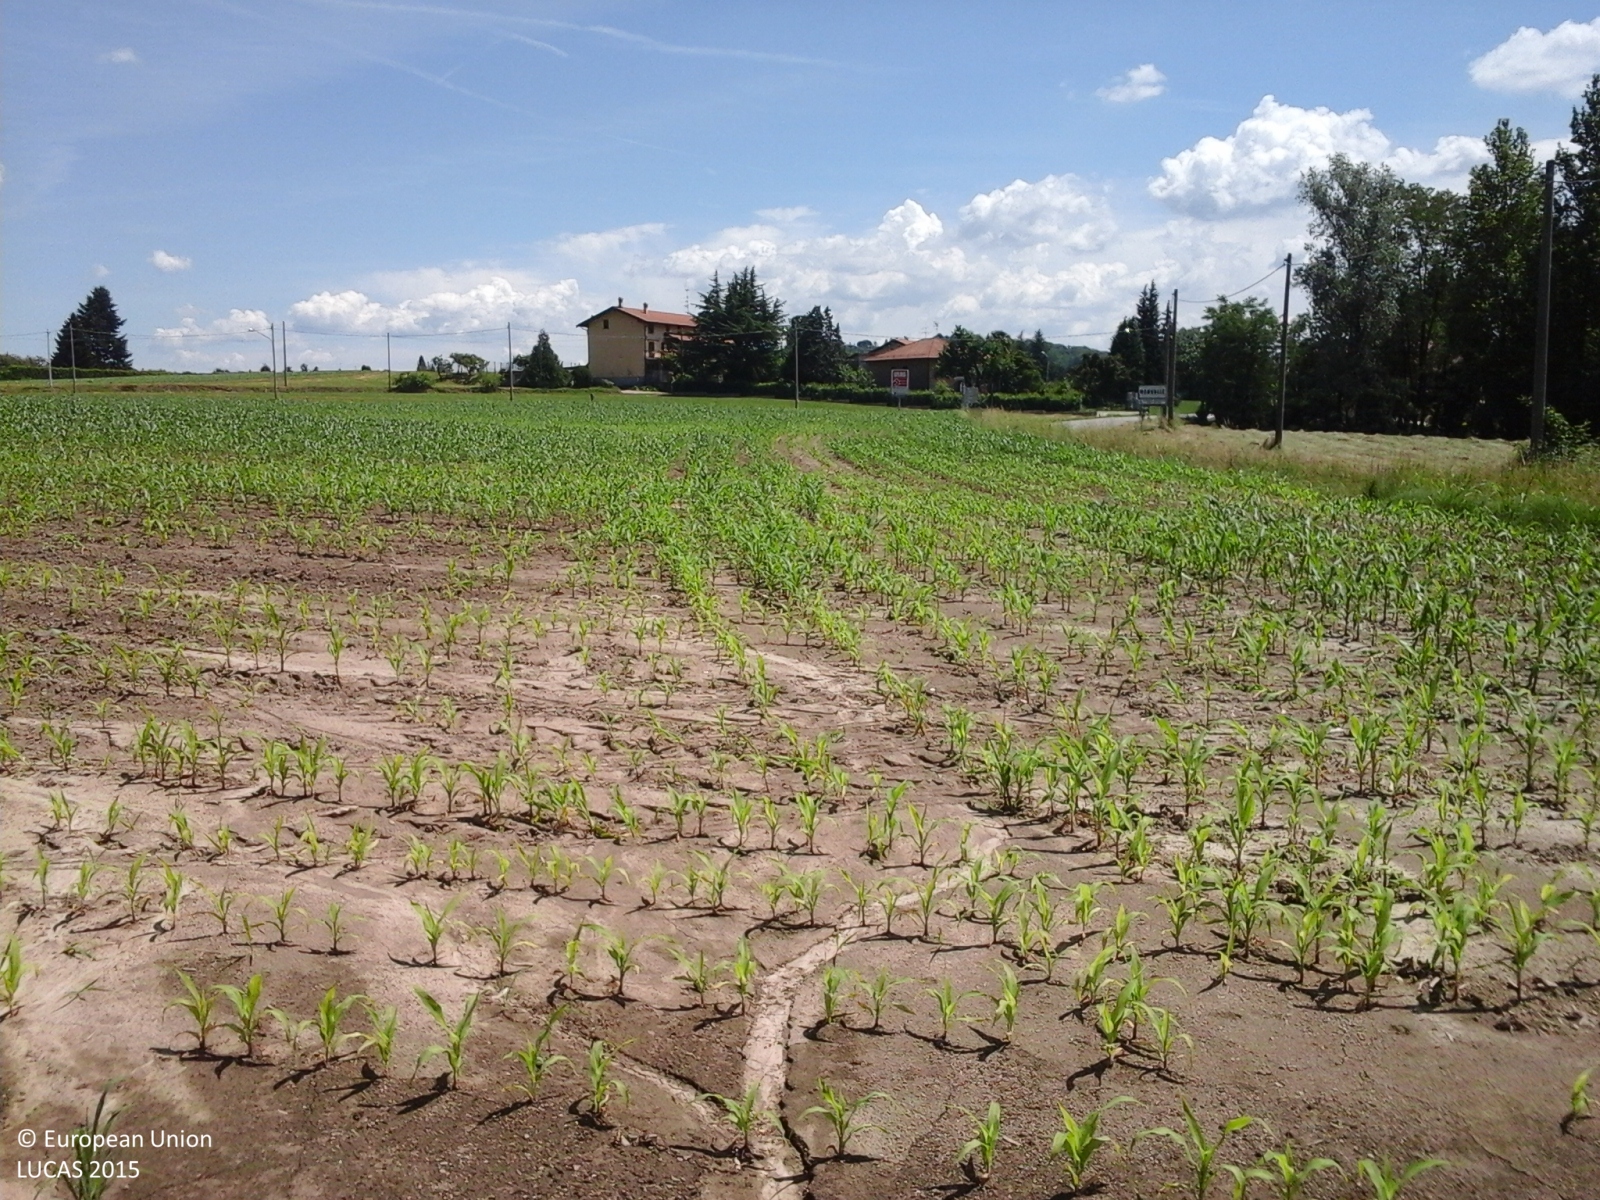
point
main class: Cropland
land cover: Maize
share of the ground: 25 - 50 %
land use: Agriculture (excluding fallow land and kitchen gardens)
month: June
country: IT
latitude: 45.8559
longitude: 8.6240
